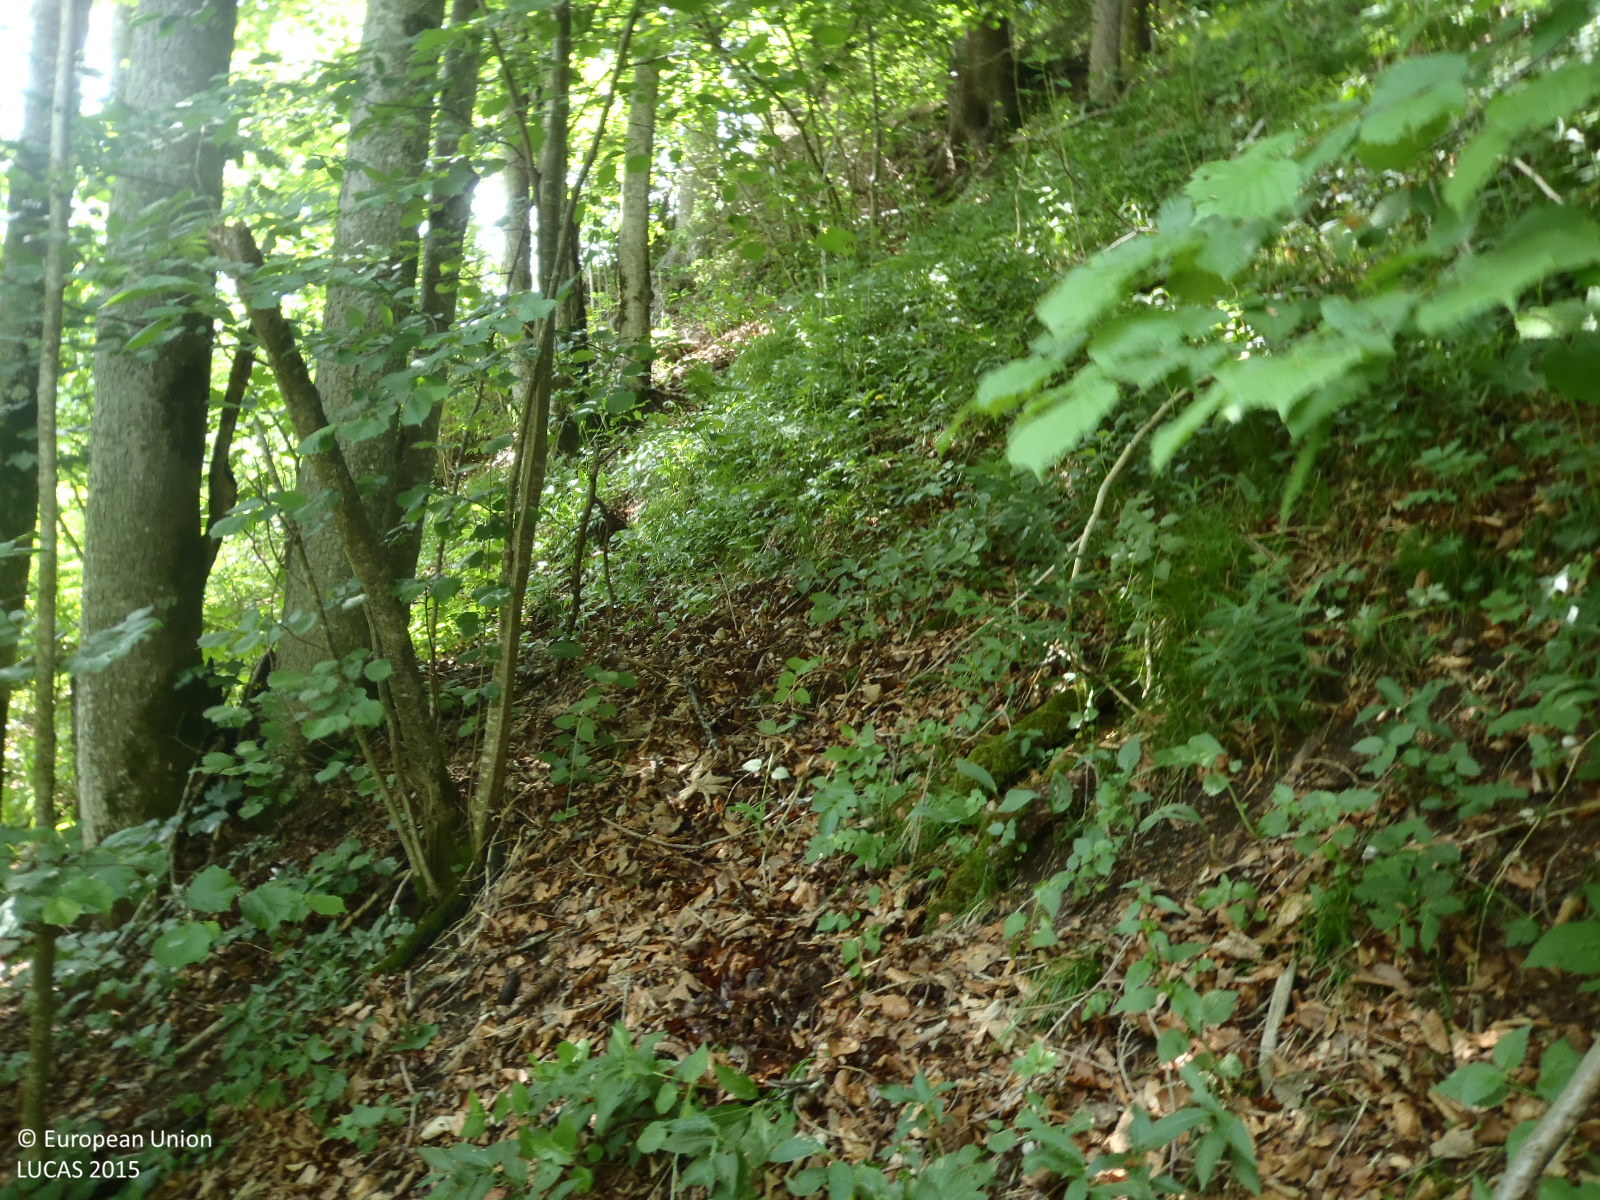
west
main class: Woodland
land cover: Broadleaved woodland
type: mesophytic deciduous forest
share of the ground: > 75 %
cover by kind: broadleaved forest trees 85 %, coniferous forest trees 5 %, shrubs 5 %, herbaceous plants 5 %
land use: Forestry
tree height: > 5 m
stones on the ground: < 10 %
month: June
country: AT
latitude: 47.4102
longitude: 10.8606
